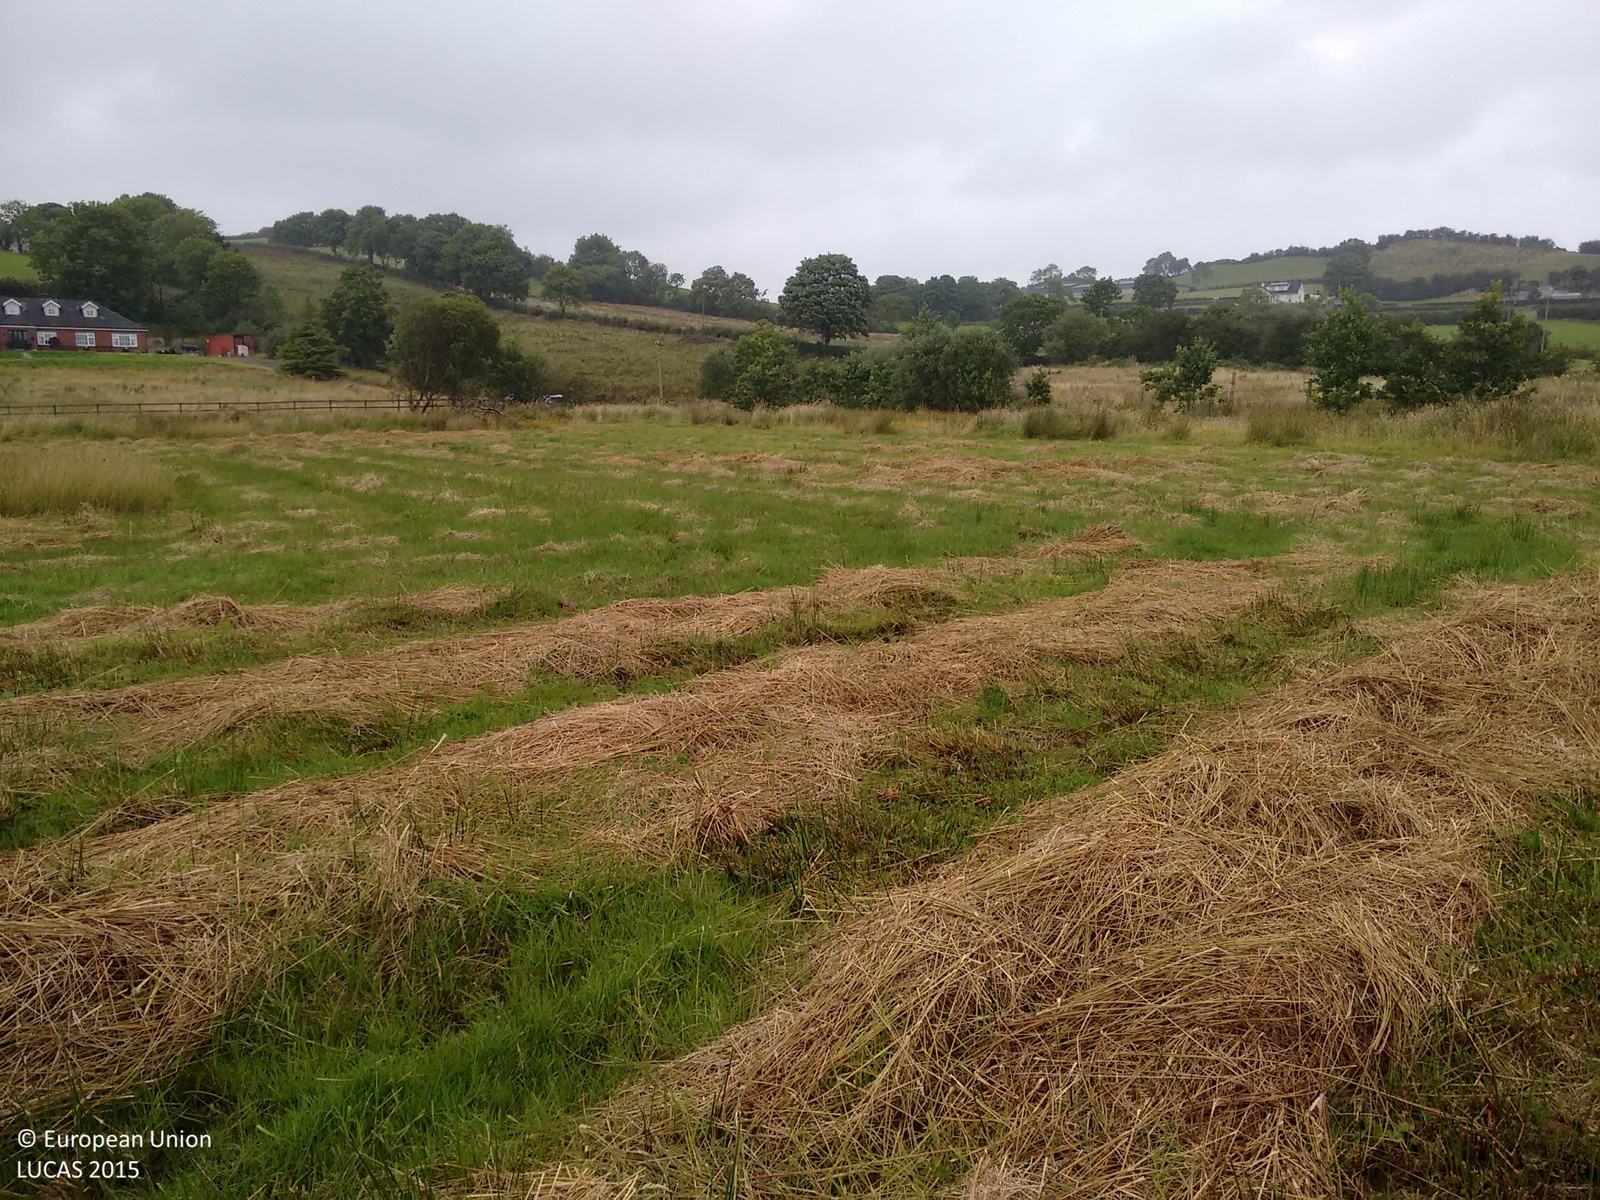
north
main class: Grassland
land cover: Grassland without tree/shrub cover
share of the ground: > 75 %
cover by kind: herbaceous plants 100 %
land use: Agriculture (excluding fallow land and kitchen gardens)
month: August
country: IE
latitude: 54.0553
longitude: -6.8005
